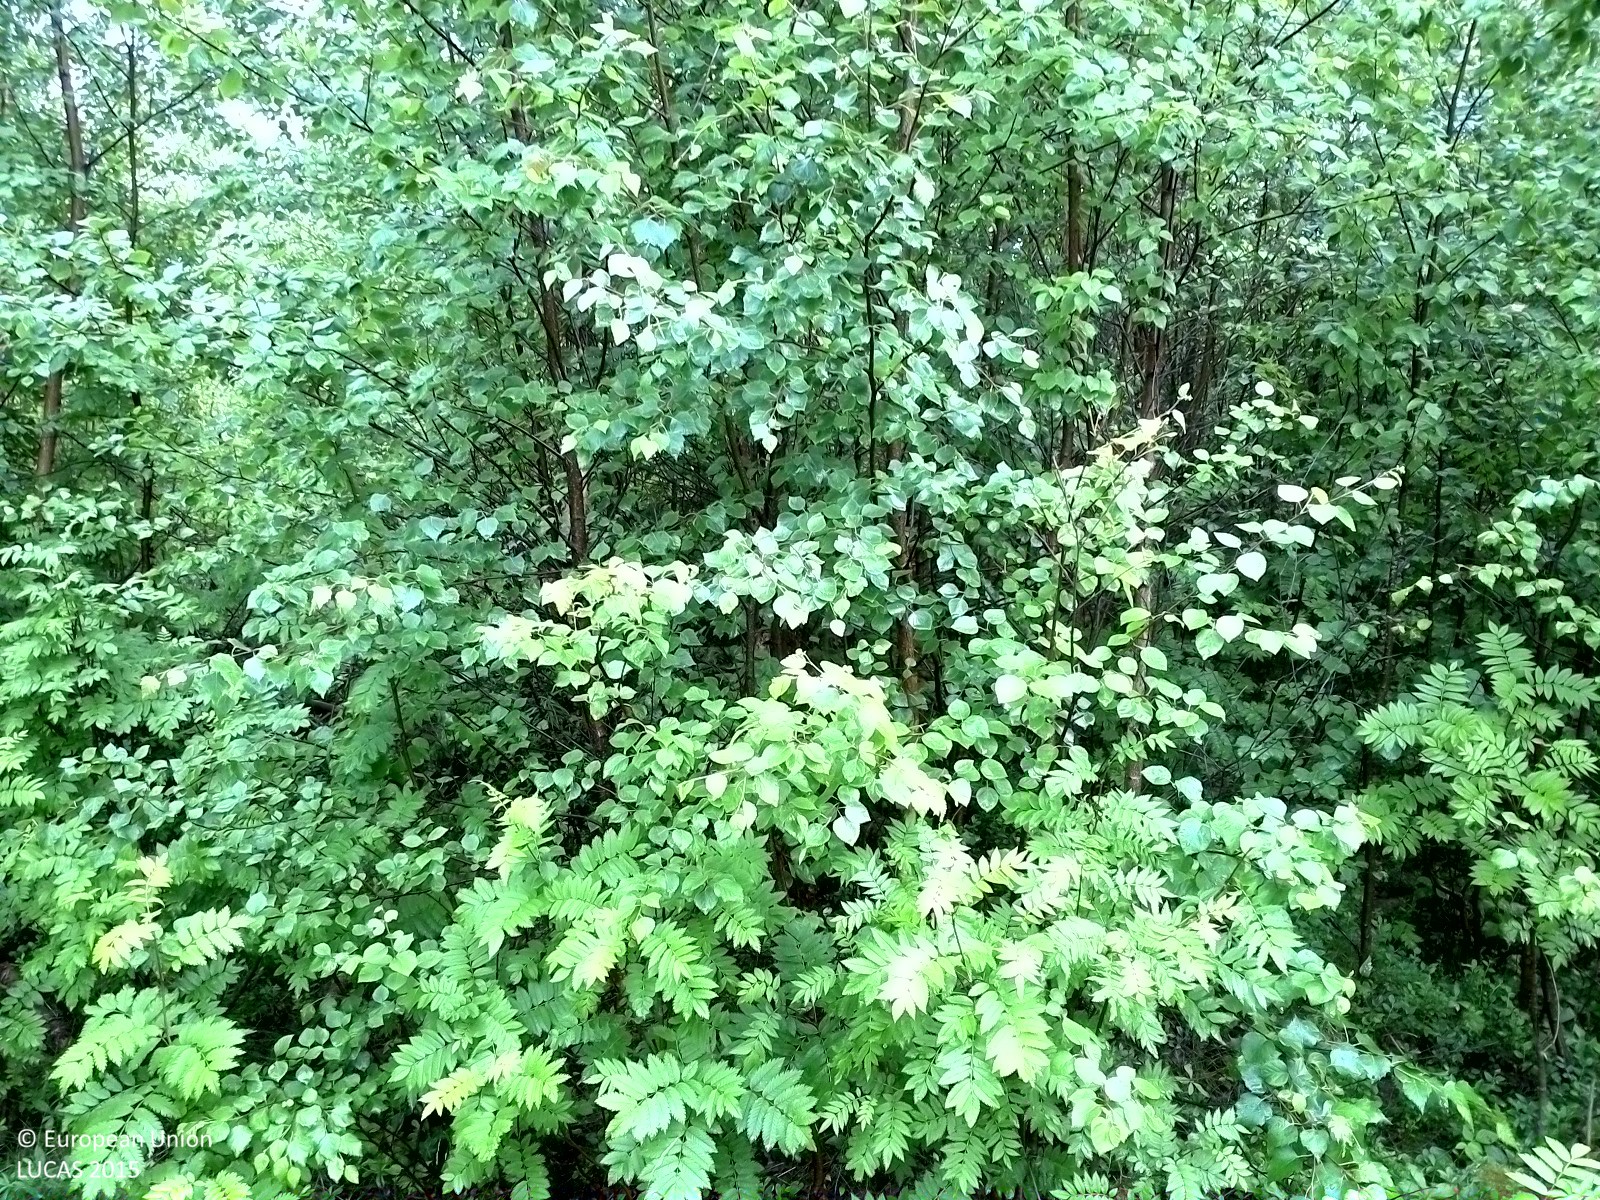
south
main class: Woodland
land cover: Broadleaved woodland
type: boreal forest
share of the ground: 50 - 75 %
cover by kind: herbaceous plants 45 %, broadleaved forest trees 40 %, coniferous forest trees 10 %, shrubs 5 %
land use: Forestry
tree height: < 5 m
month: July
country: SE
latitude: 62.6197
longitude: 17.6005
